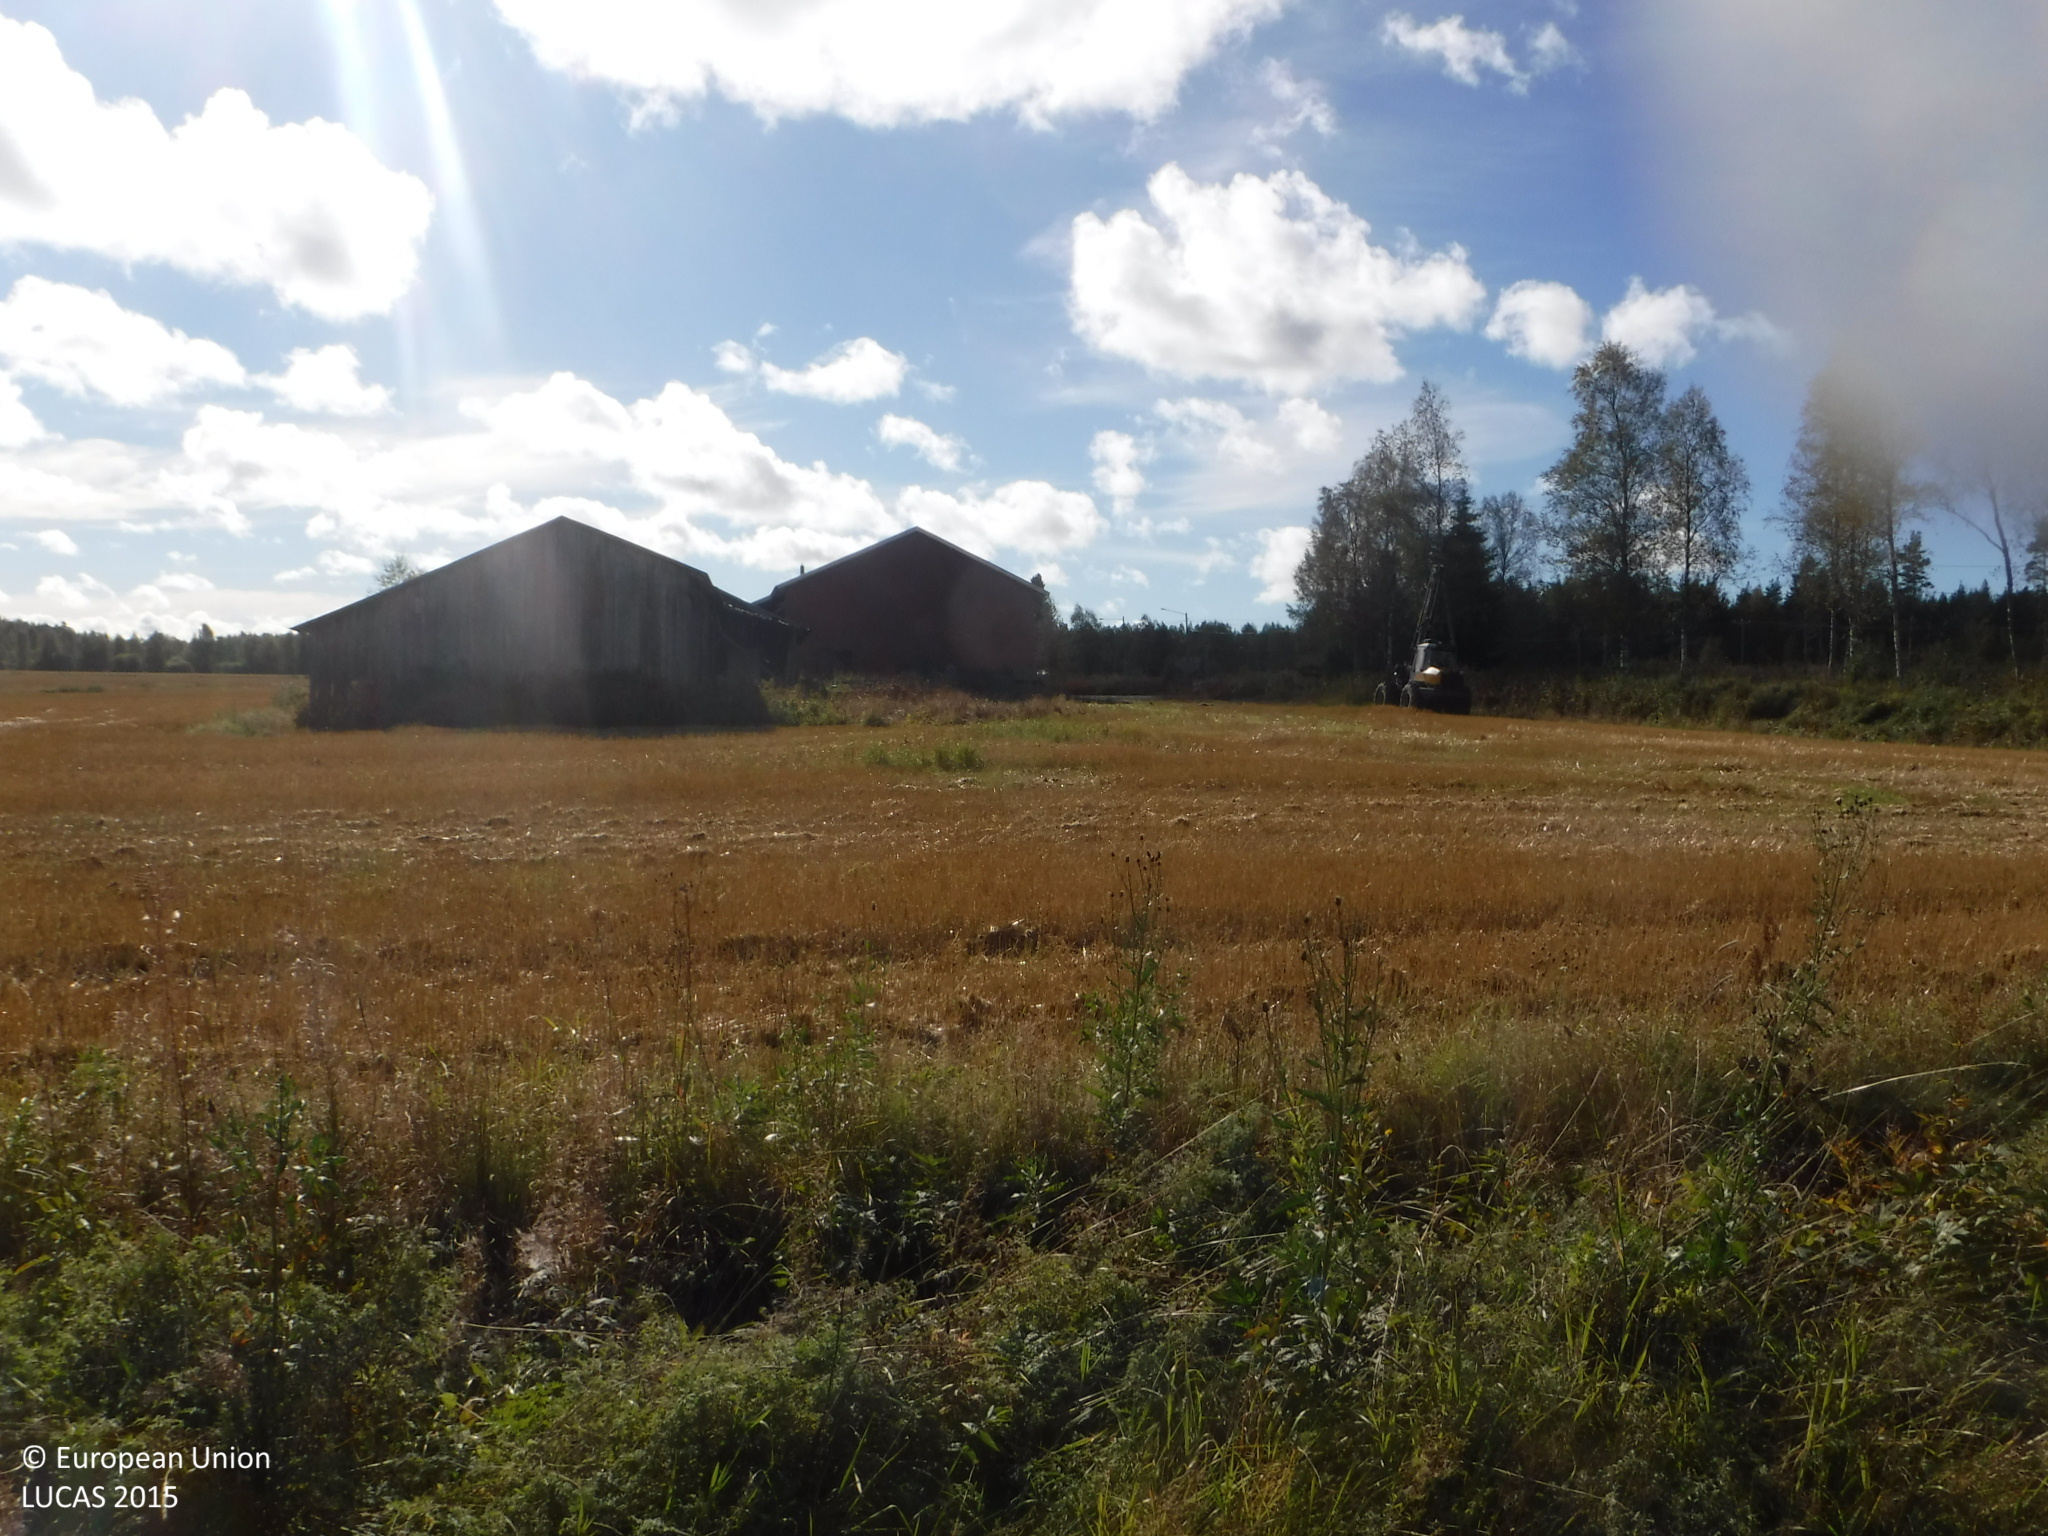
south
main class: Cropland
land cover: Oats
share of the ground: > 75 %
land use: Agriculture (excluding fallow land and kitchen gardens)
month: September
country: FI
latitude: 62.1460
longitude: 21.5774
